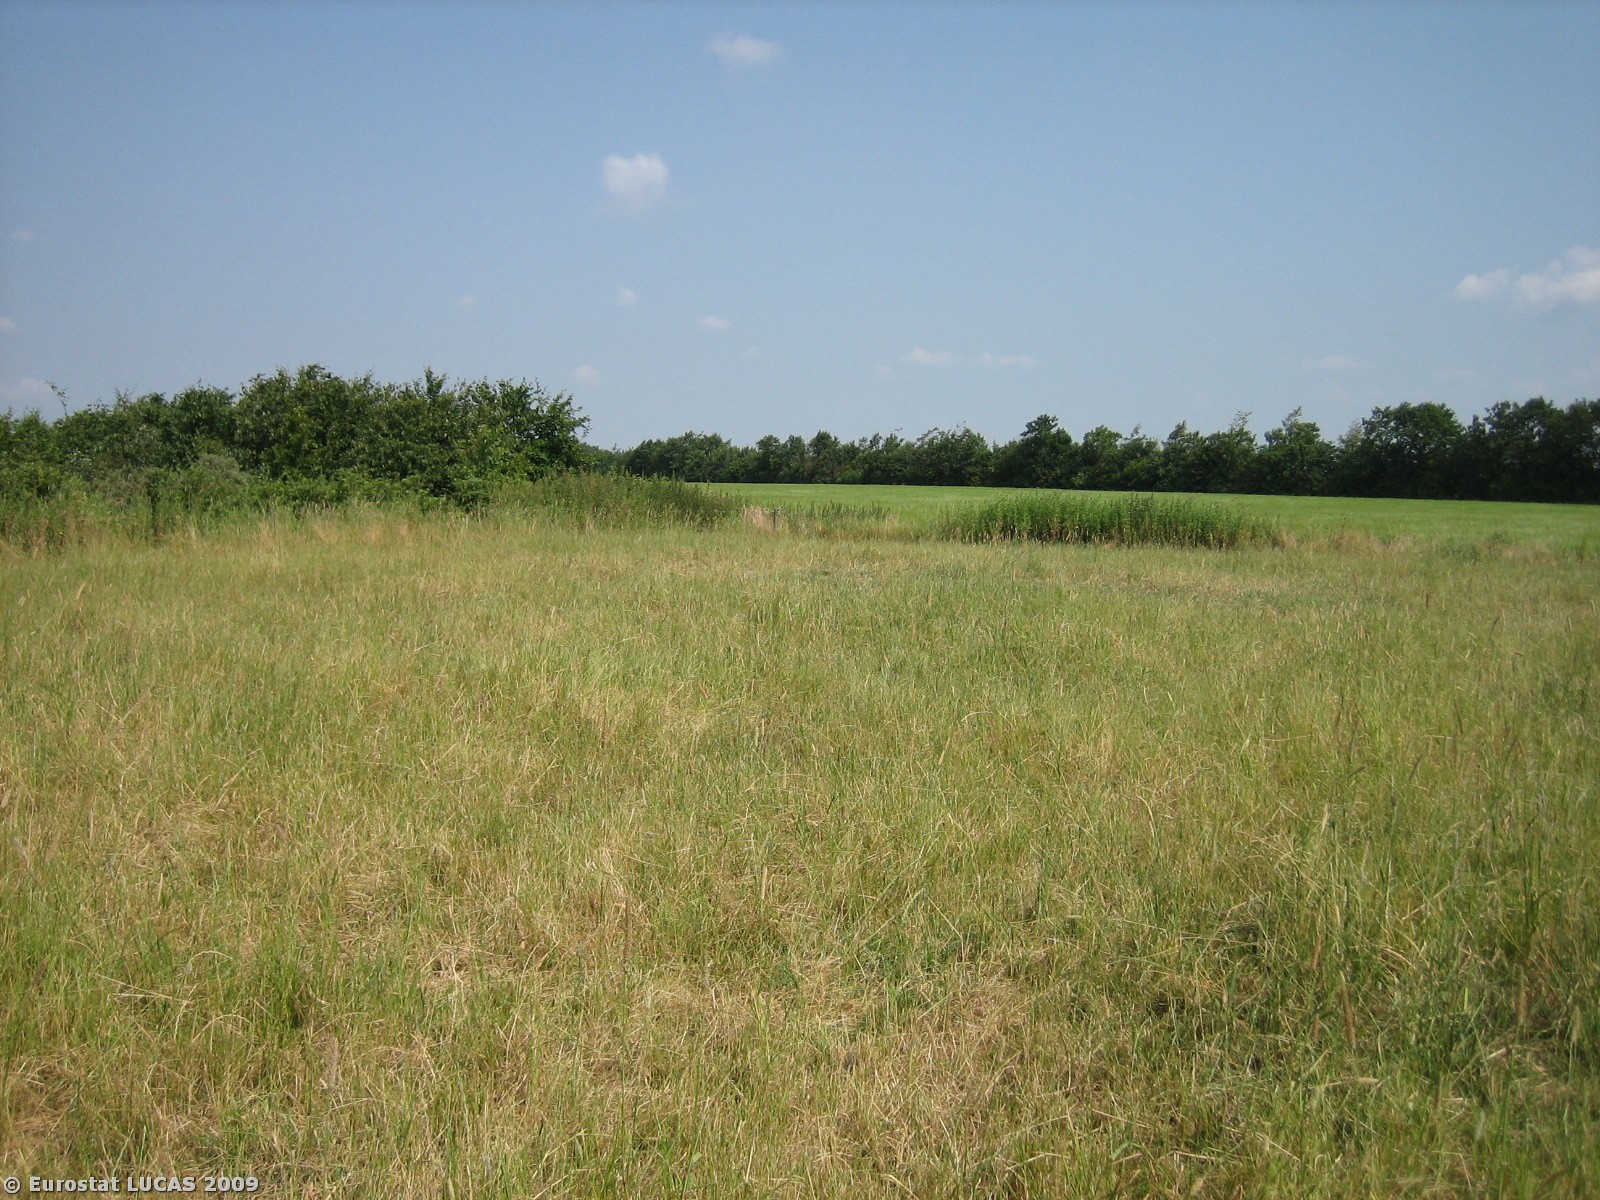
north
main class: Grassland
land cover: Grassland without tree/shrub cover
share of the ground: > 75 %
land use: Agriculture (excluding fallow land and kitchen gardens)
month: July
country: DK
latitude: 55.5354
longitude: 8.8444
